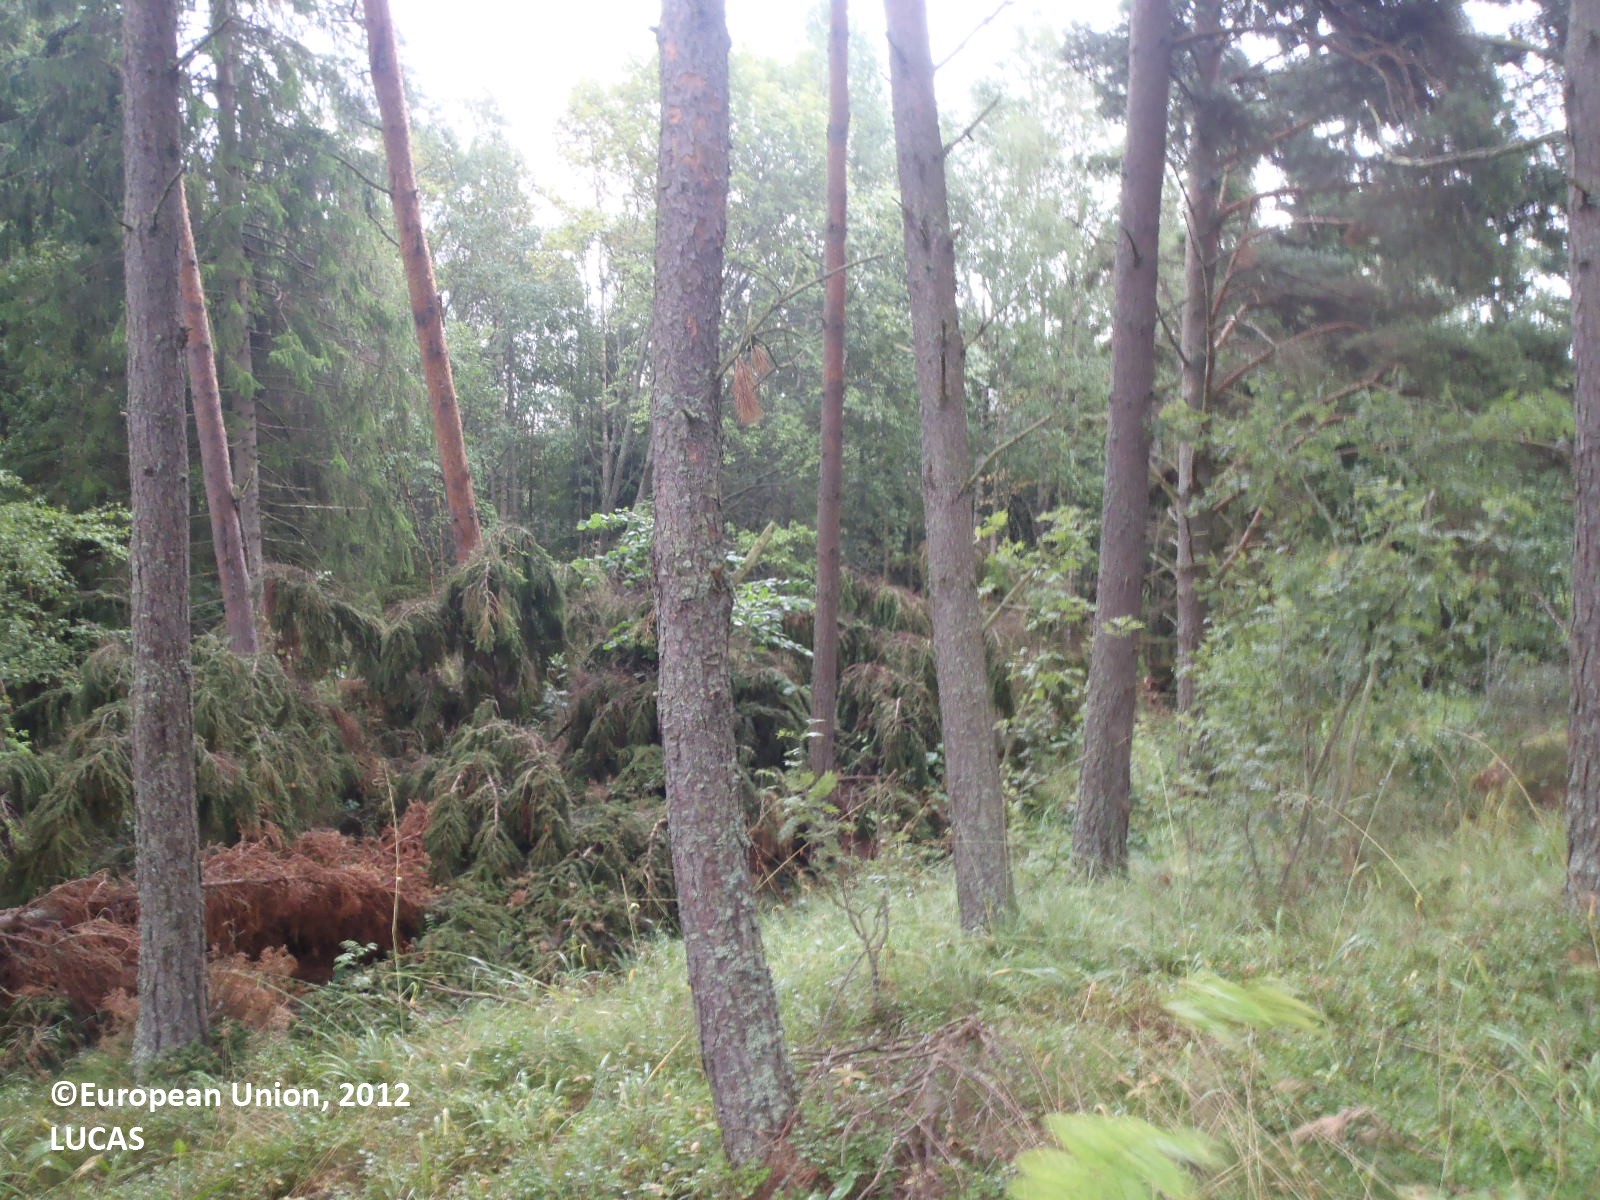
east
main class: Woodland
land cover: Pine dominated coniferous woodland
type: hemiboreal forest and nemoral coniferous forest and mixed broadleaved-coniferous forest
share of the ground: > 75 %
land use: Forestry
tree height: > 5 m
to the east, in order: Pine dominated coniferous woodland; Spruce dominated mixed woodland; Broadleaved woodland; Ditches and canals; Broadleaved woodland; Spruce dominated coniferous woodland; Conifer hedges; Lichens and moss; Conifer hedges; Broadleaved woodland; Salt marshes
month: August
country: FI
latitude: 60.3187
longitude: 20.9321
